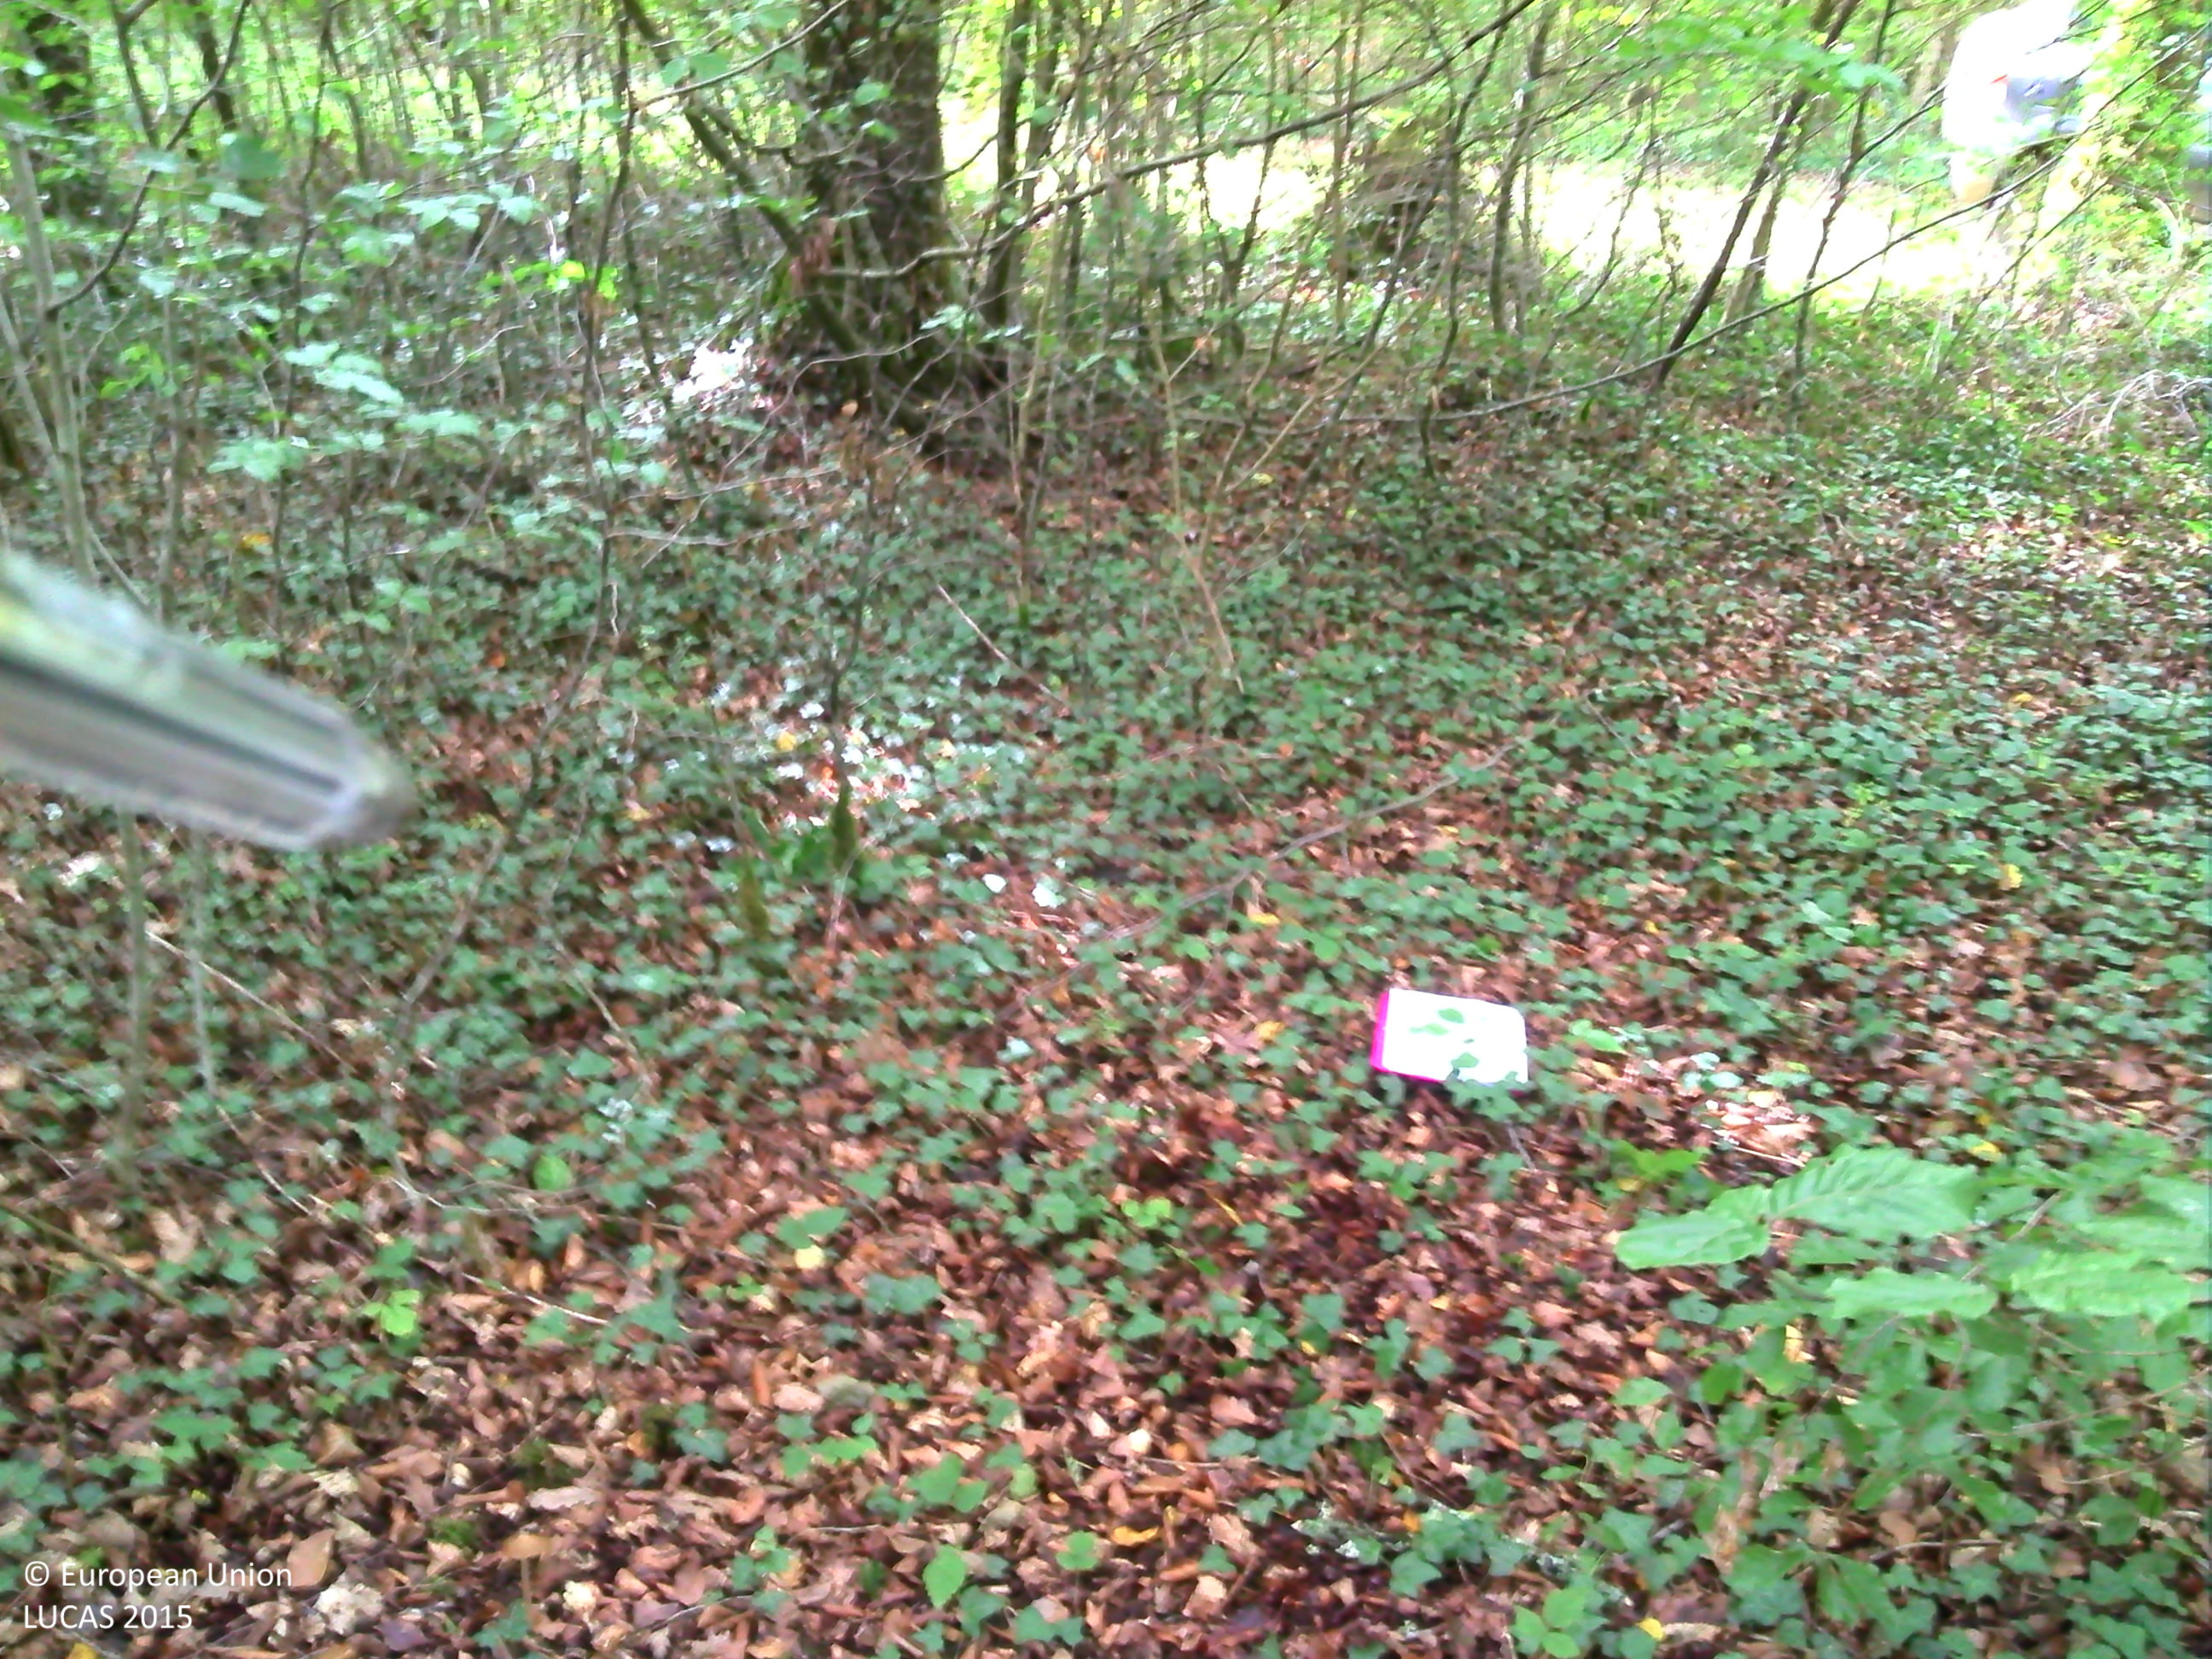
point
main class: Woodland
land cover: Broadleaved woodland
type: mesophytic deciduous forest
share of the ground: > 75 %
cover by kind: broadleaved forest trees 90 %, herbaceous plants 5 %, lichens and mosses 5 %
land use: Forestry
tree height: > 5 m
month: September
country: FR
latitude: 48.2547
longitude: 4.6238
